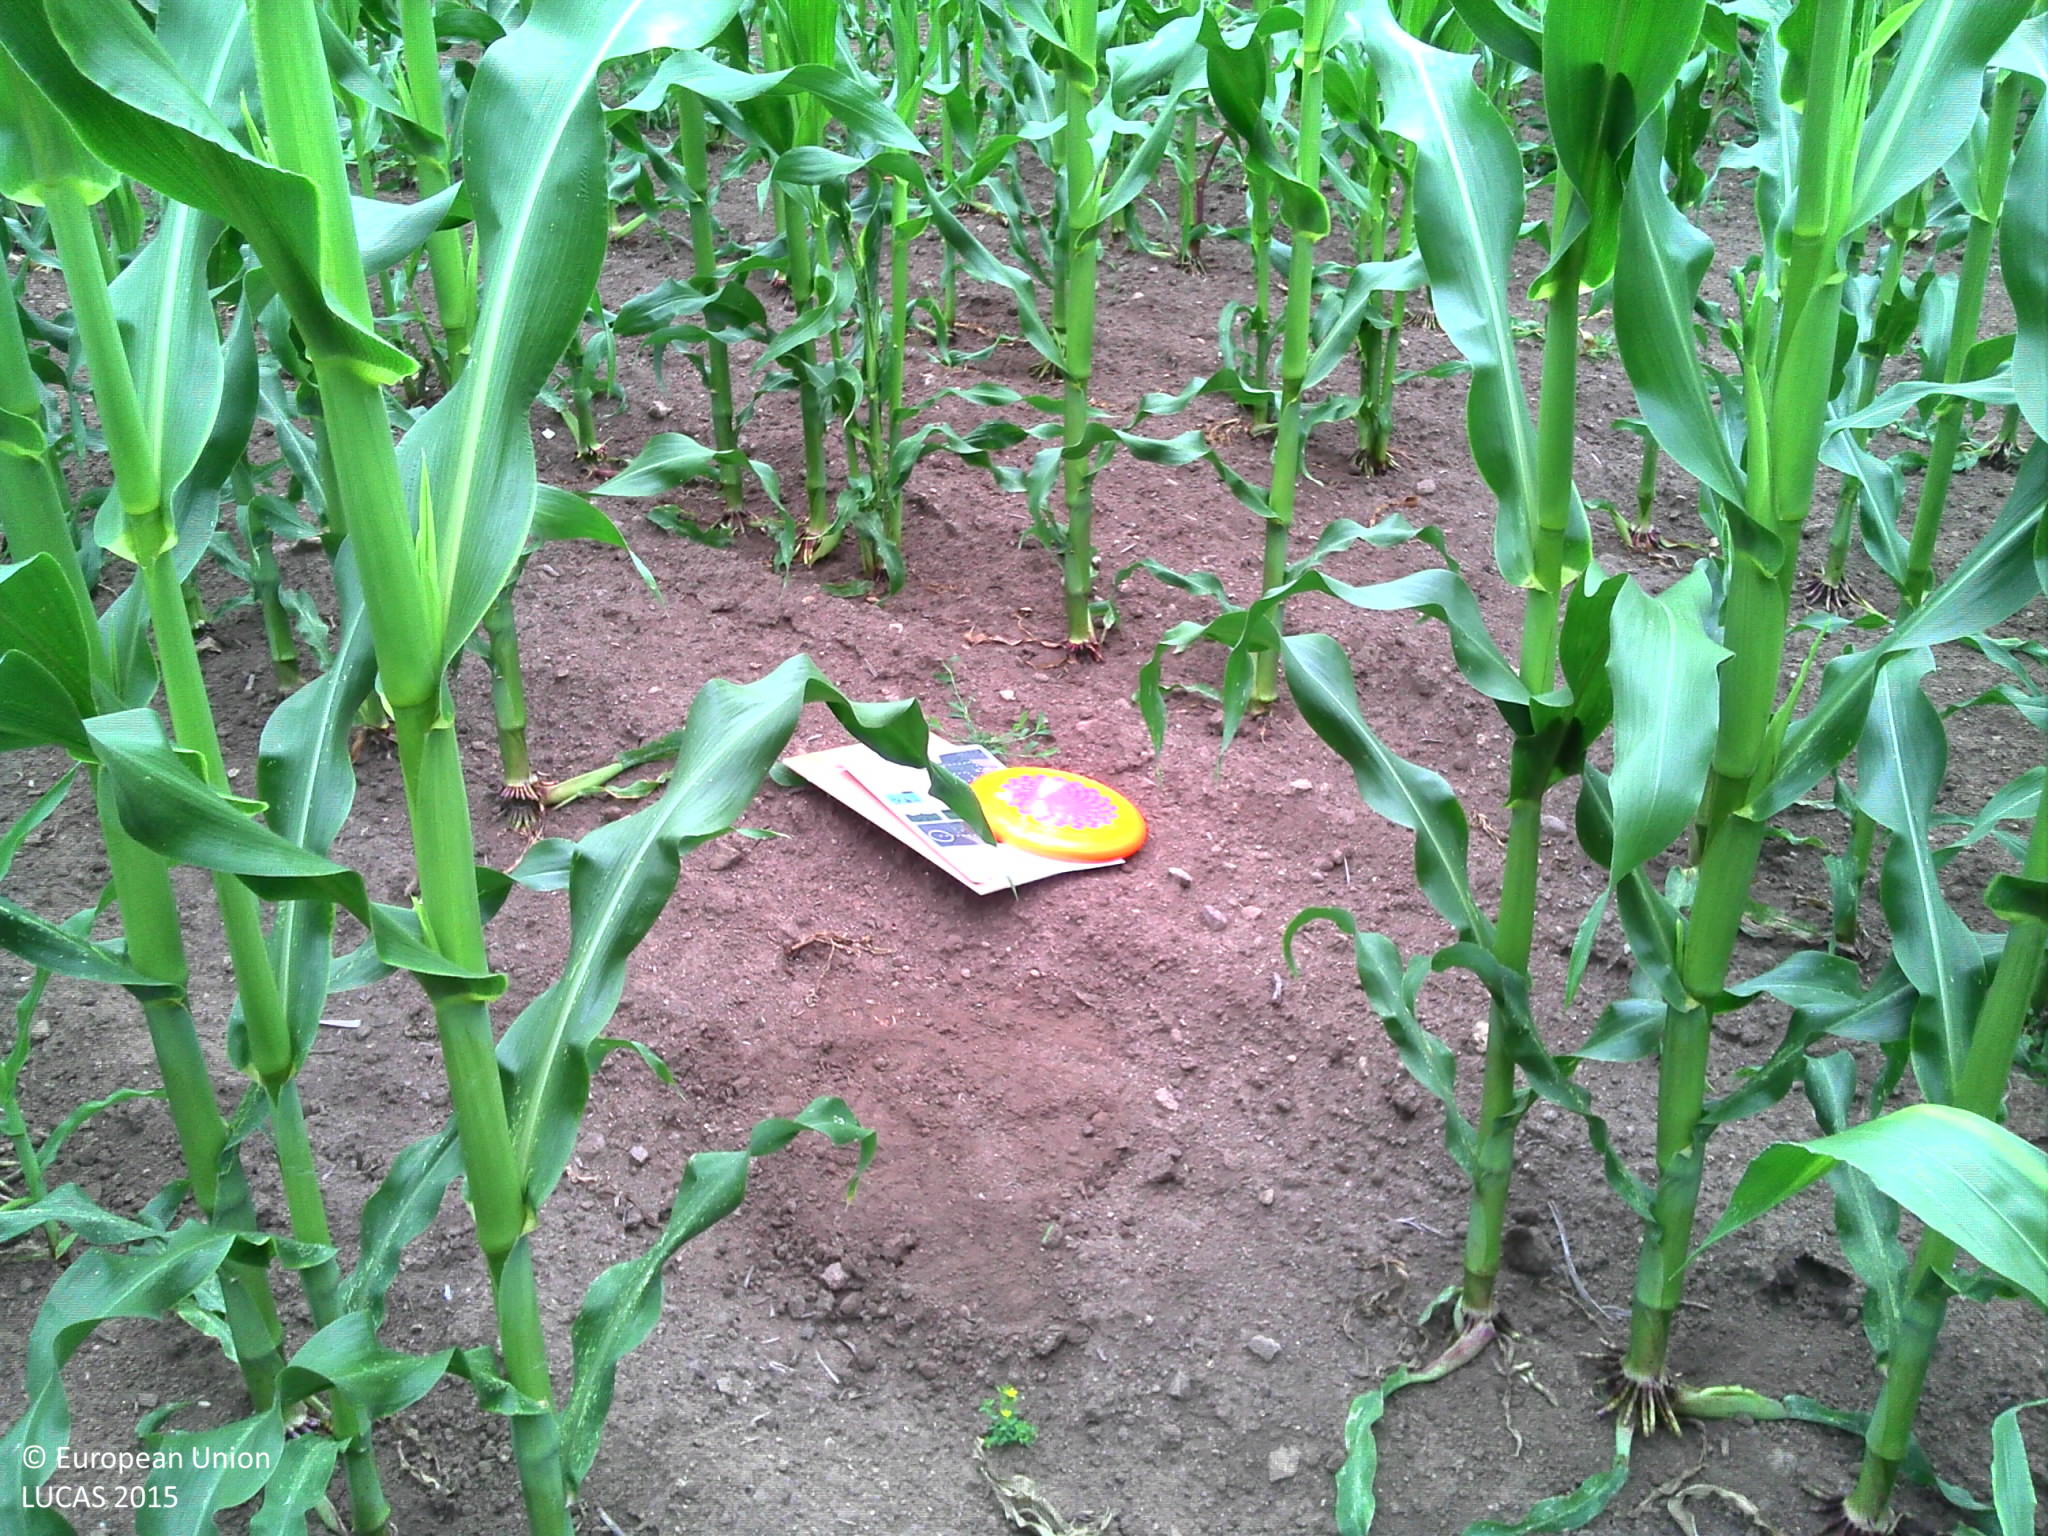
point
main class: Cropland
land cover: Maize
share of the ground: > 75 %
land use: Agriculture (excluding fallow land and kitchen gardens)
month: July
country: FR
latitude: 47.7462
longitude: -3.2617
